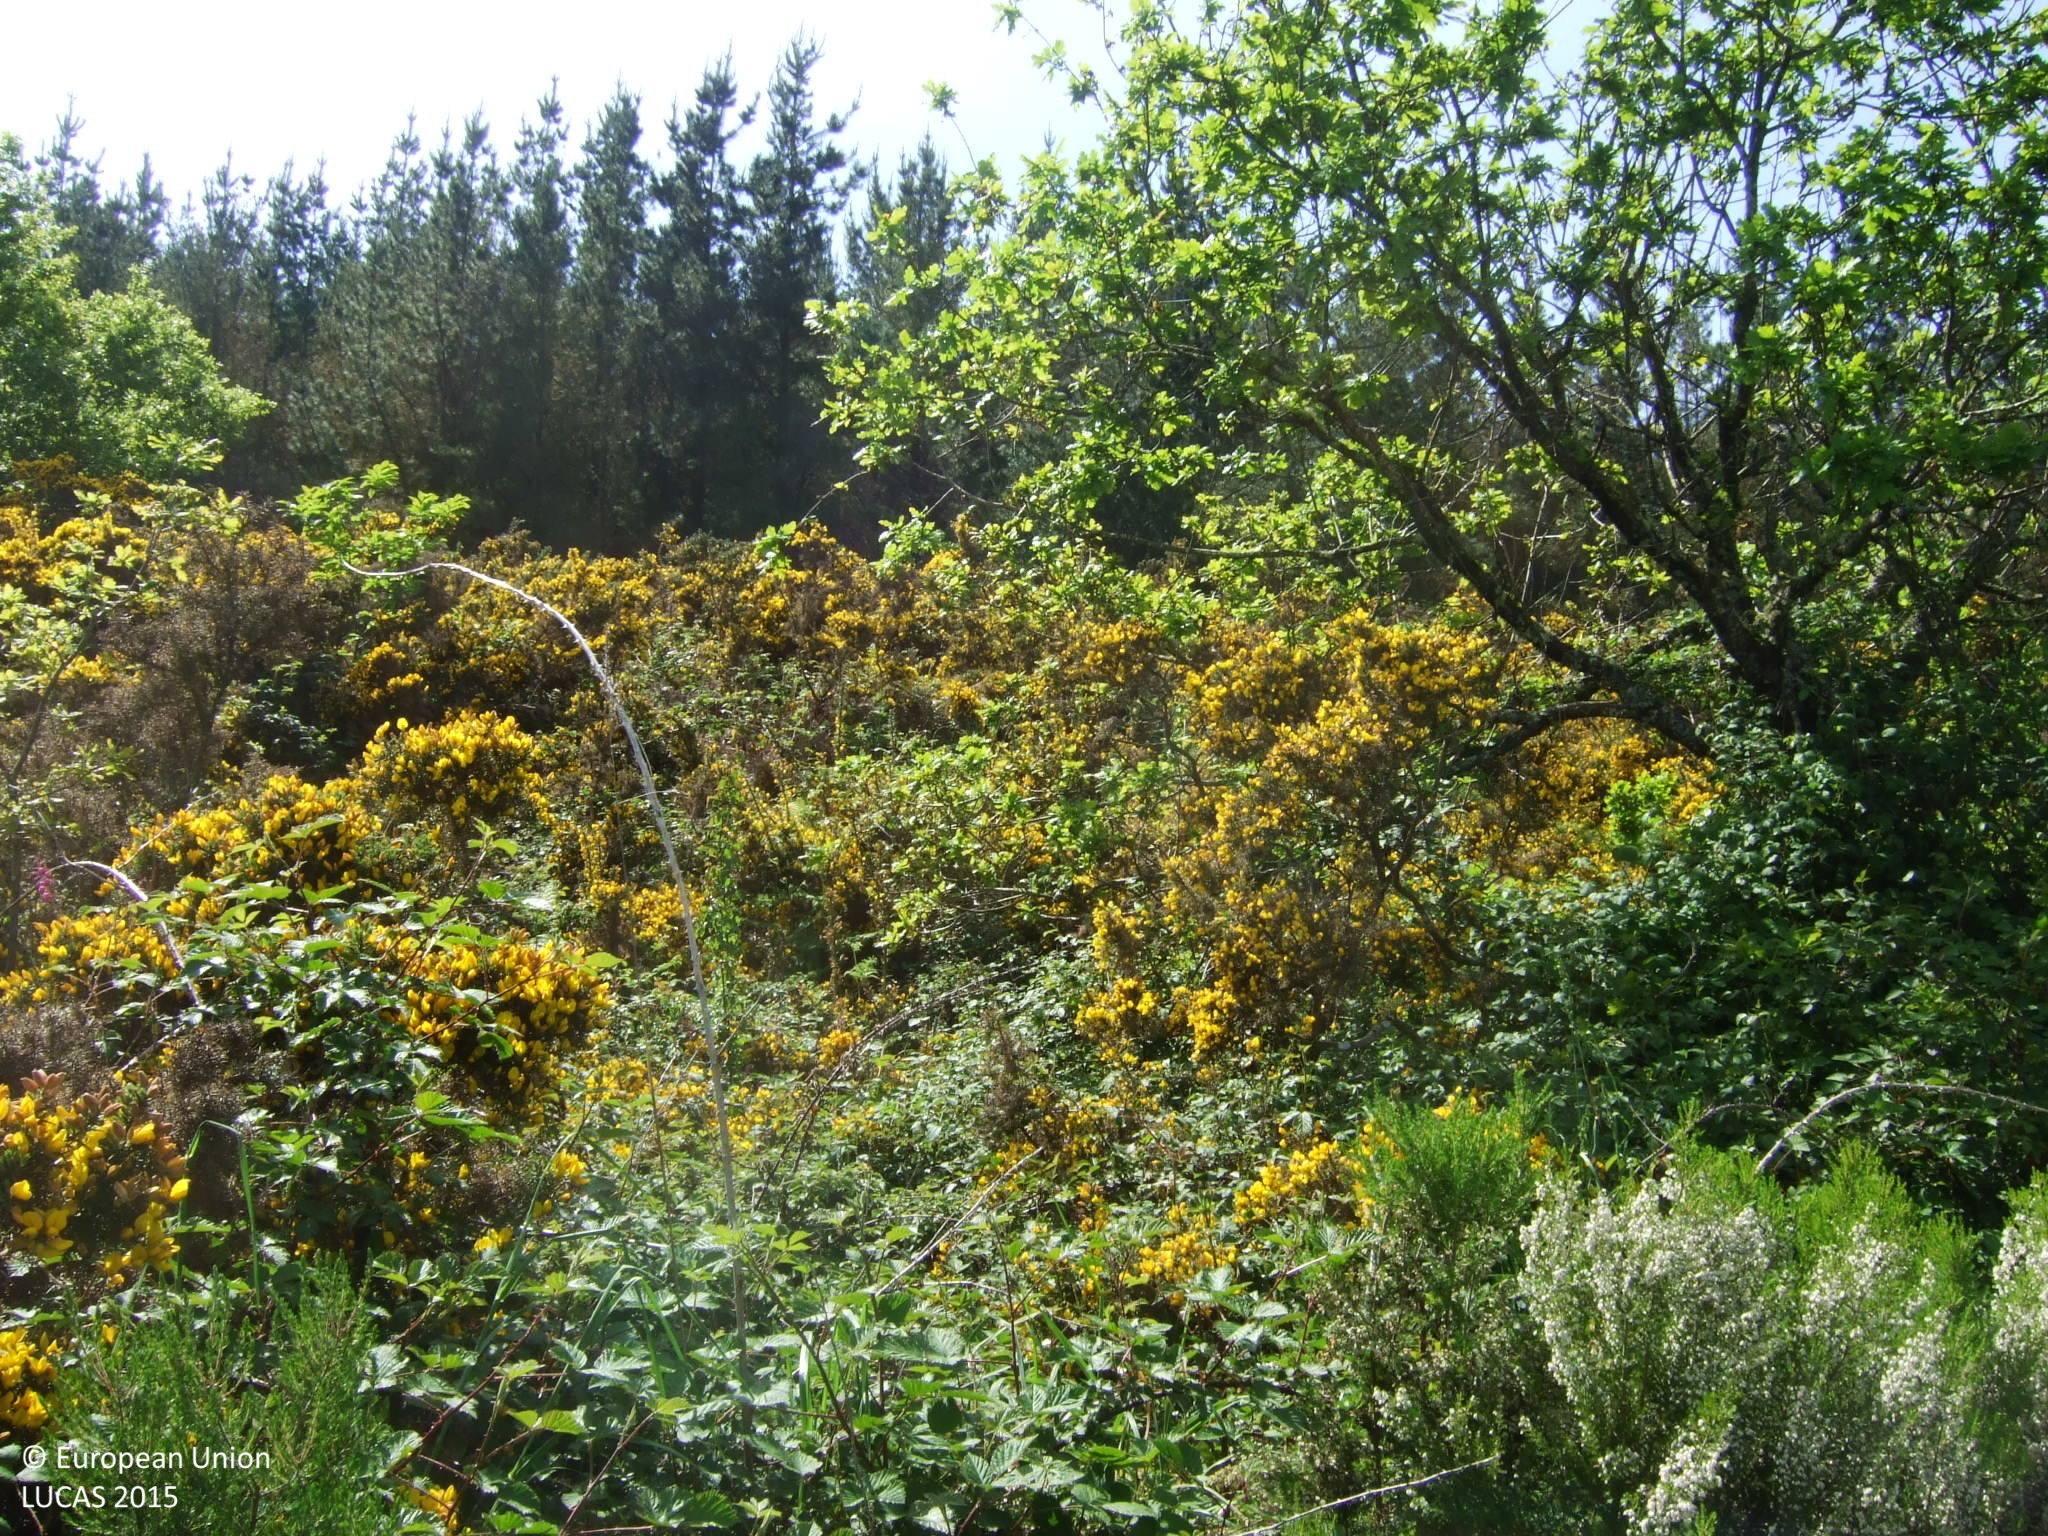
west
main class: Shrubland
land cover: Shrubland without tree cover
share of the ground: > 75 %
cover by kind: shrubs 100 %
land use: Abandoned areas
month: May
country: ES
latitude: 43.0948
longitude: -7.3587
